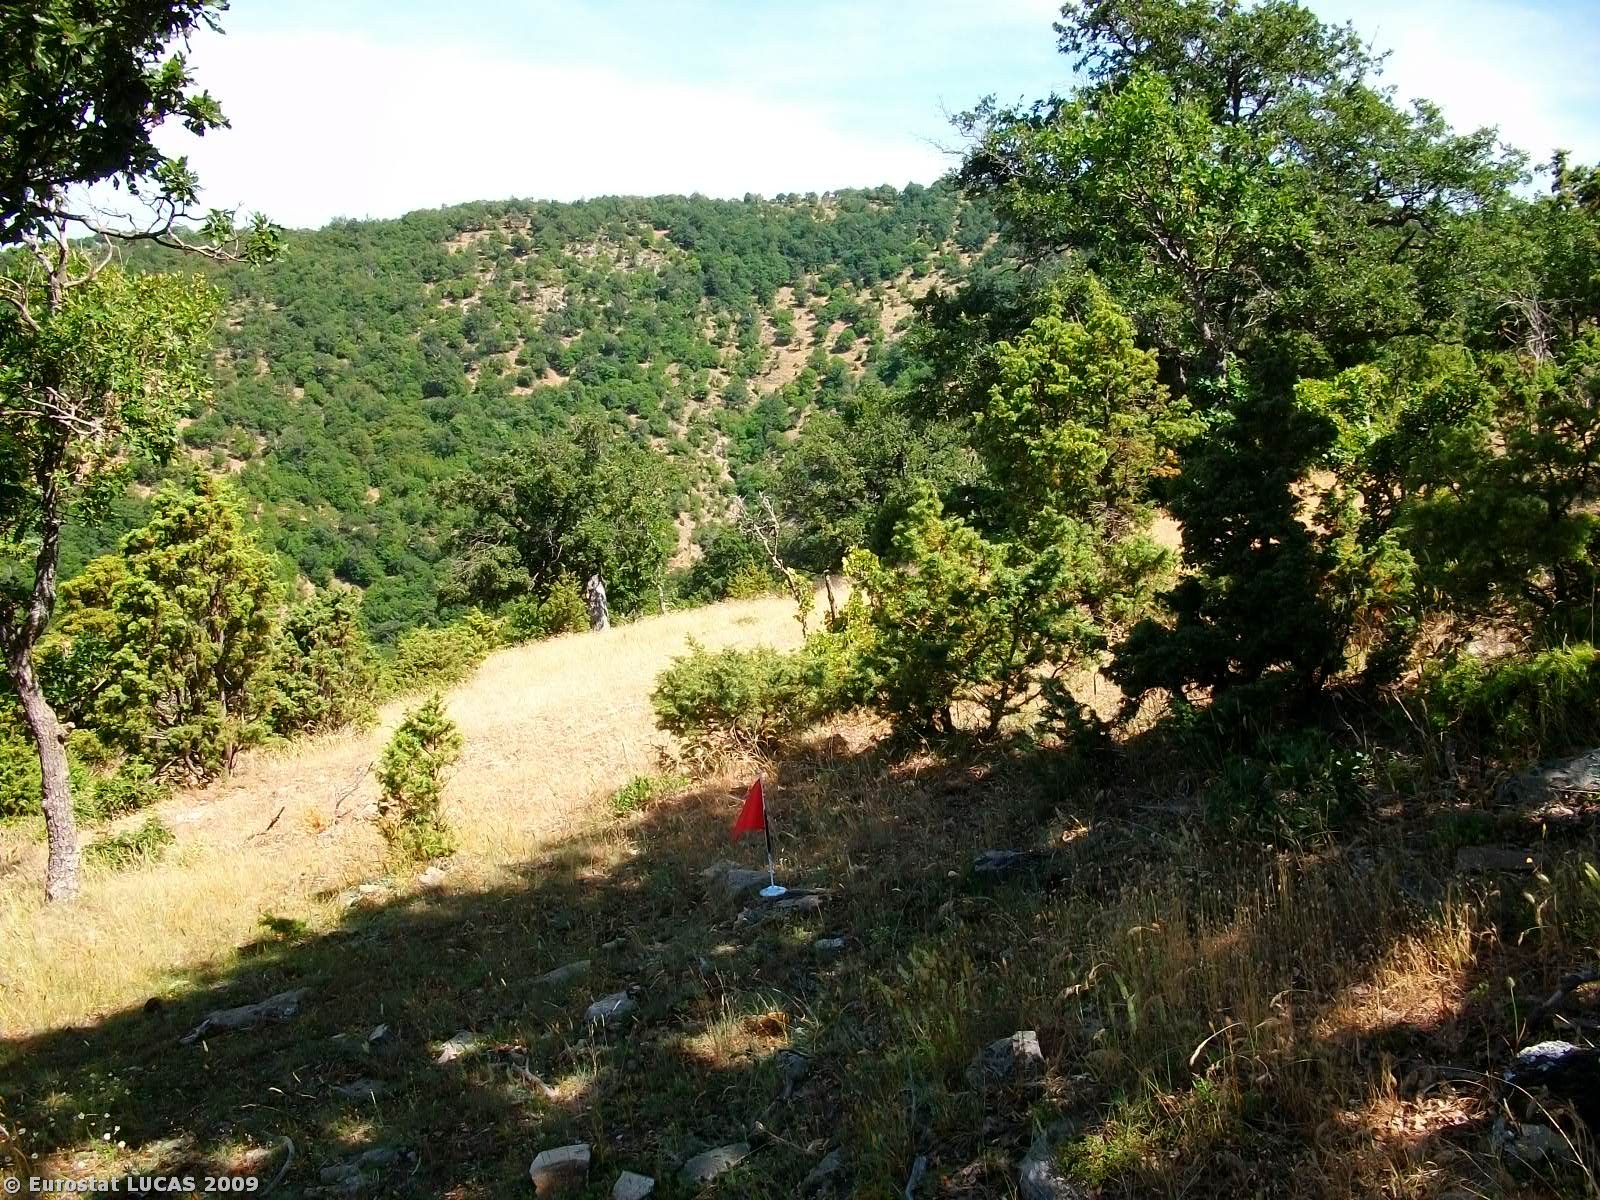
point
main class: Woodland
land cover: Broadleaved woodland
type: thermophilous deciduous forest
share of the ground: > 75 %
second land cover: Grassland with sparse tree/shrub cover
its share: > 75 %
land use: Agriculture (excluding fallow land and kitchen gardens)
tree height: > 5 m
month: June
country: GR
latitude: 41.1403
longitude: 25.8453
